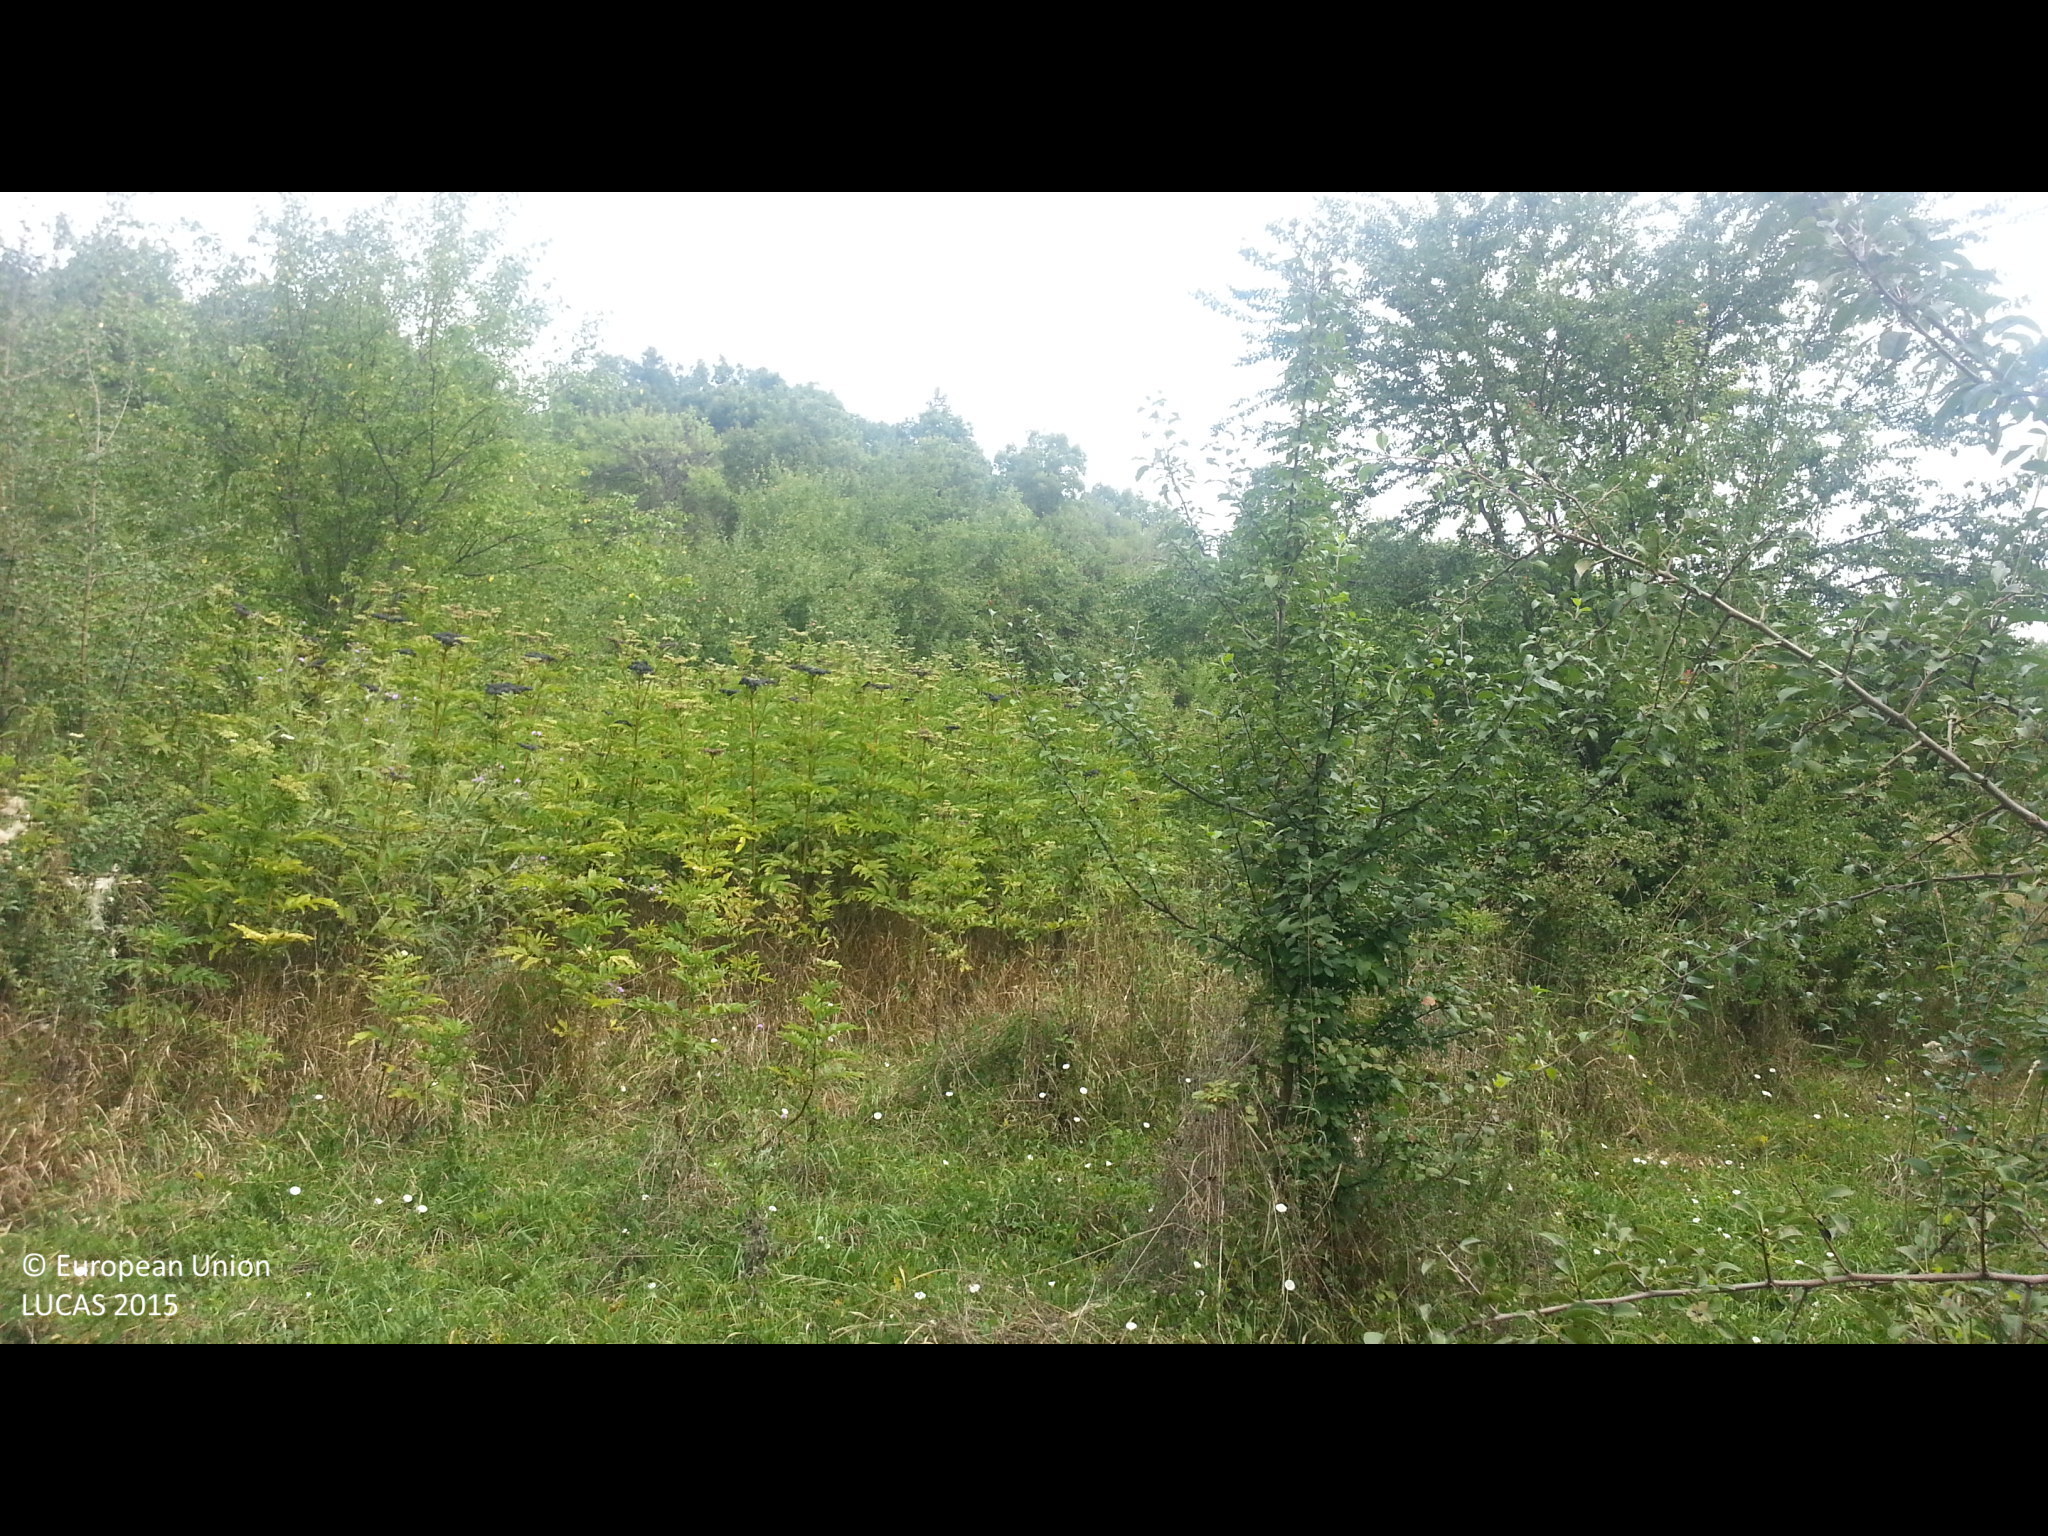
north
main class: Grassland
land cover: Grassland with sparse tree/shrub cover
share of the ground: > 75 %
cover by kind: herbaceous plants 85 %, shrubs 10 %, broadleaved forest trees 5 %
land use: Semi-natural and natural areas not in use
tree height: < 5 m
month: August
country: BG
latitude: 42.4020
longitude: 22.8180
